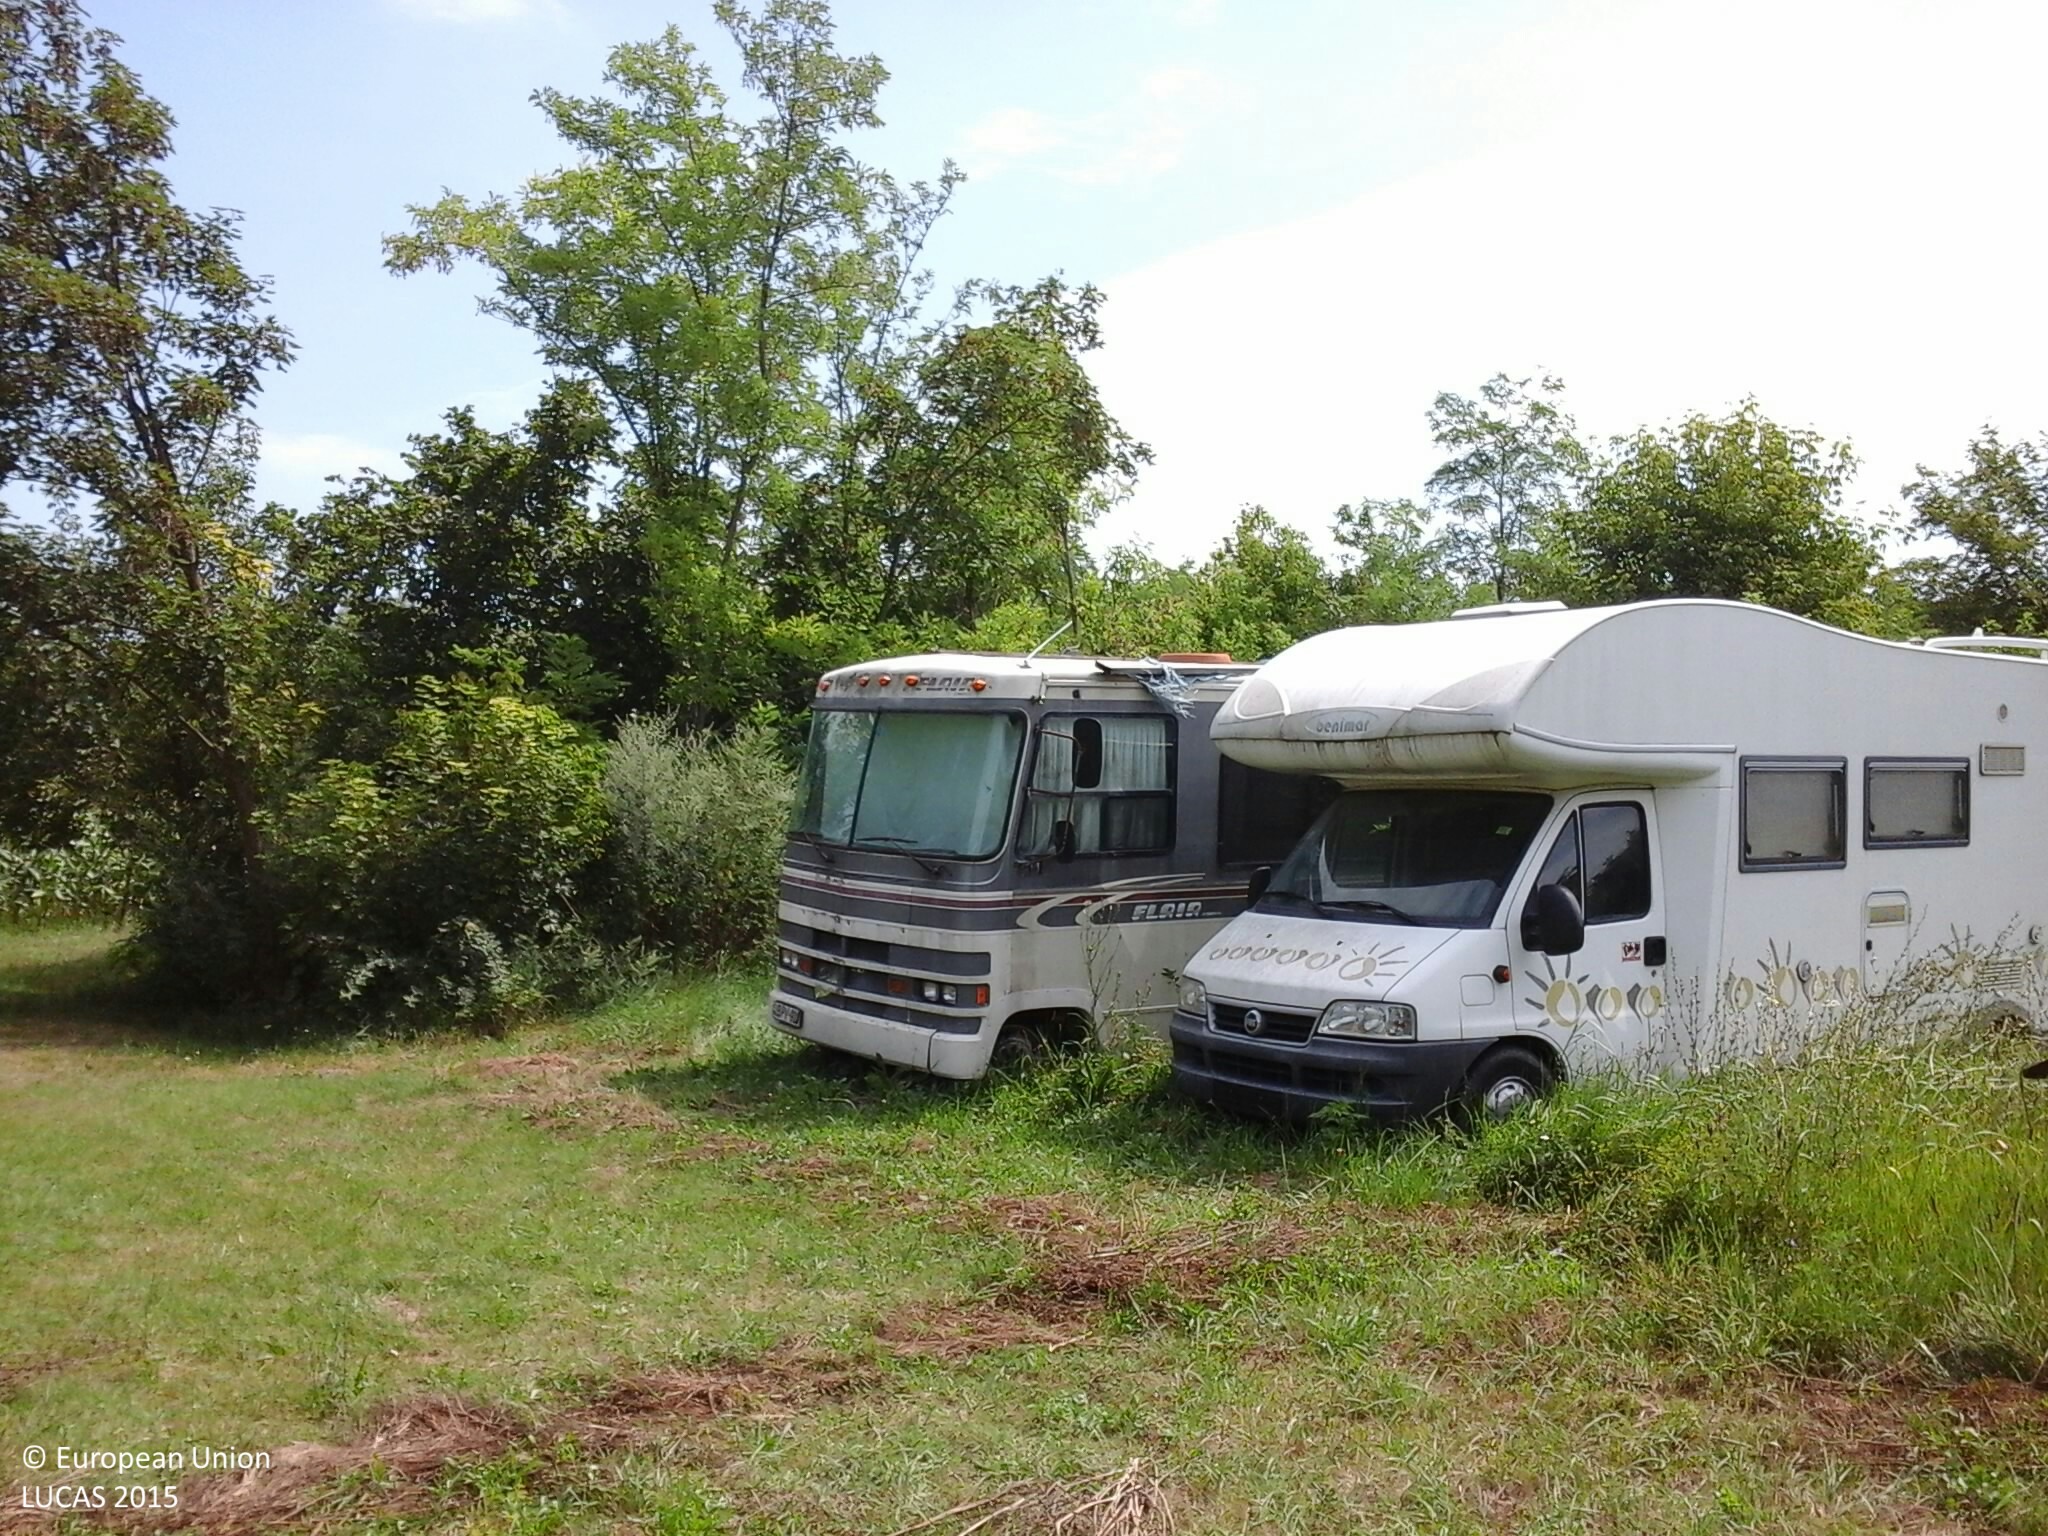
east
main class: Grassland
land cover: Grassland without tree/shrub cover
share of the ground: > 75 %
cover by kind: herbaceous plants 100 %
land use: Agriculture (excluding fallow land and kitchen gardens)
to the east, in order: Grassland without tree/shrub cover; Broadleaved woodland; Grass margins; Conifer hedges; Maize; Fences; Broadleaved woodland; Electric lines; Grass margins; Paved roads, cycling and walking lanes; Grass margins; Inland fresh running water; Grass margins
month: August
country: HU
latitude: 46.8975
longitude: 18.0554
